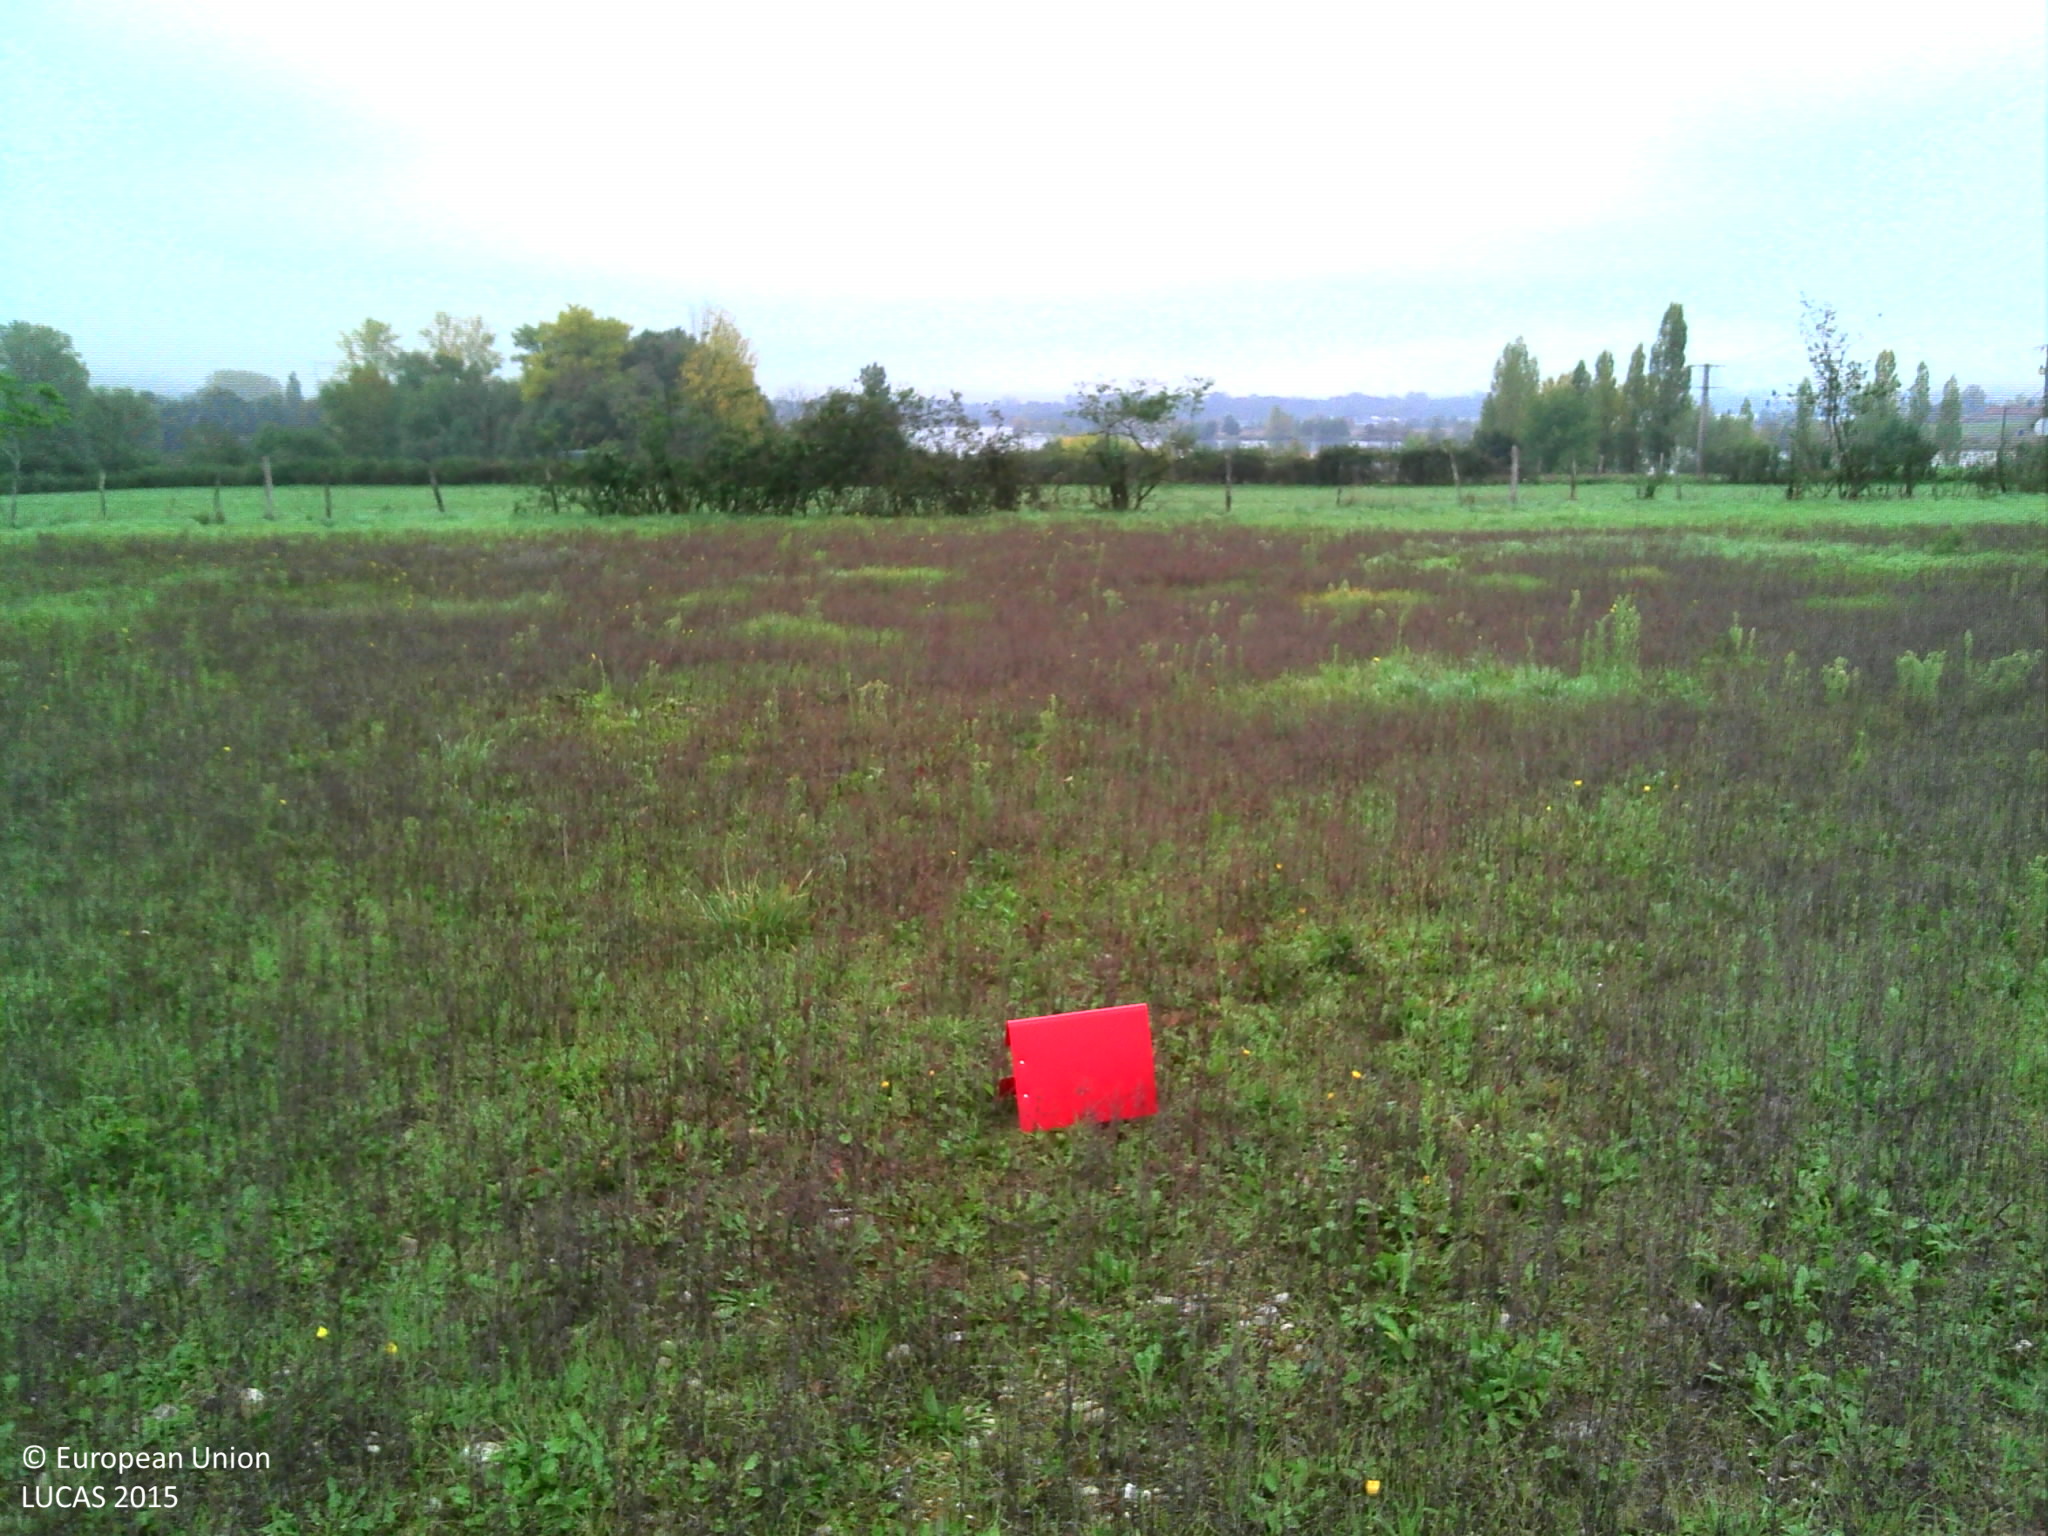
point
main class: Grassland
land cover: Spontaneously vegetated surfaces
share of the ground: > 75 %
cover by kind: herbaceous plants 100 %
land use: Agriculture (excluding fallow land and kitchen gardens)
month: October
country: FR
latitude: 45.8387
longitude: 5.4332
